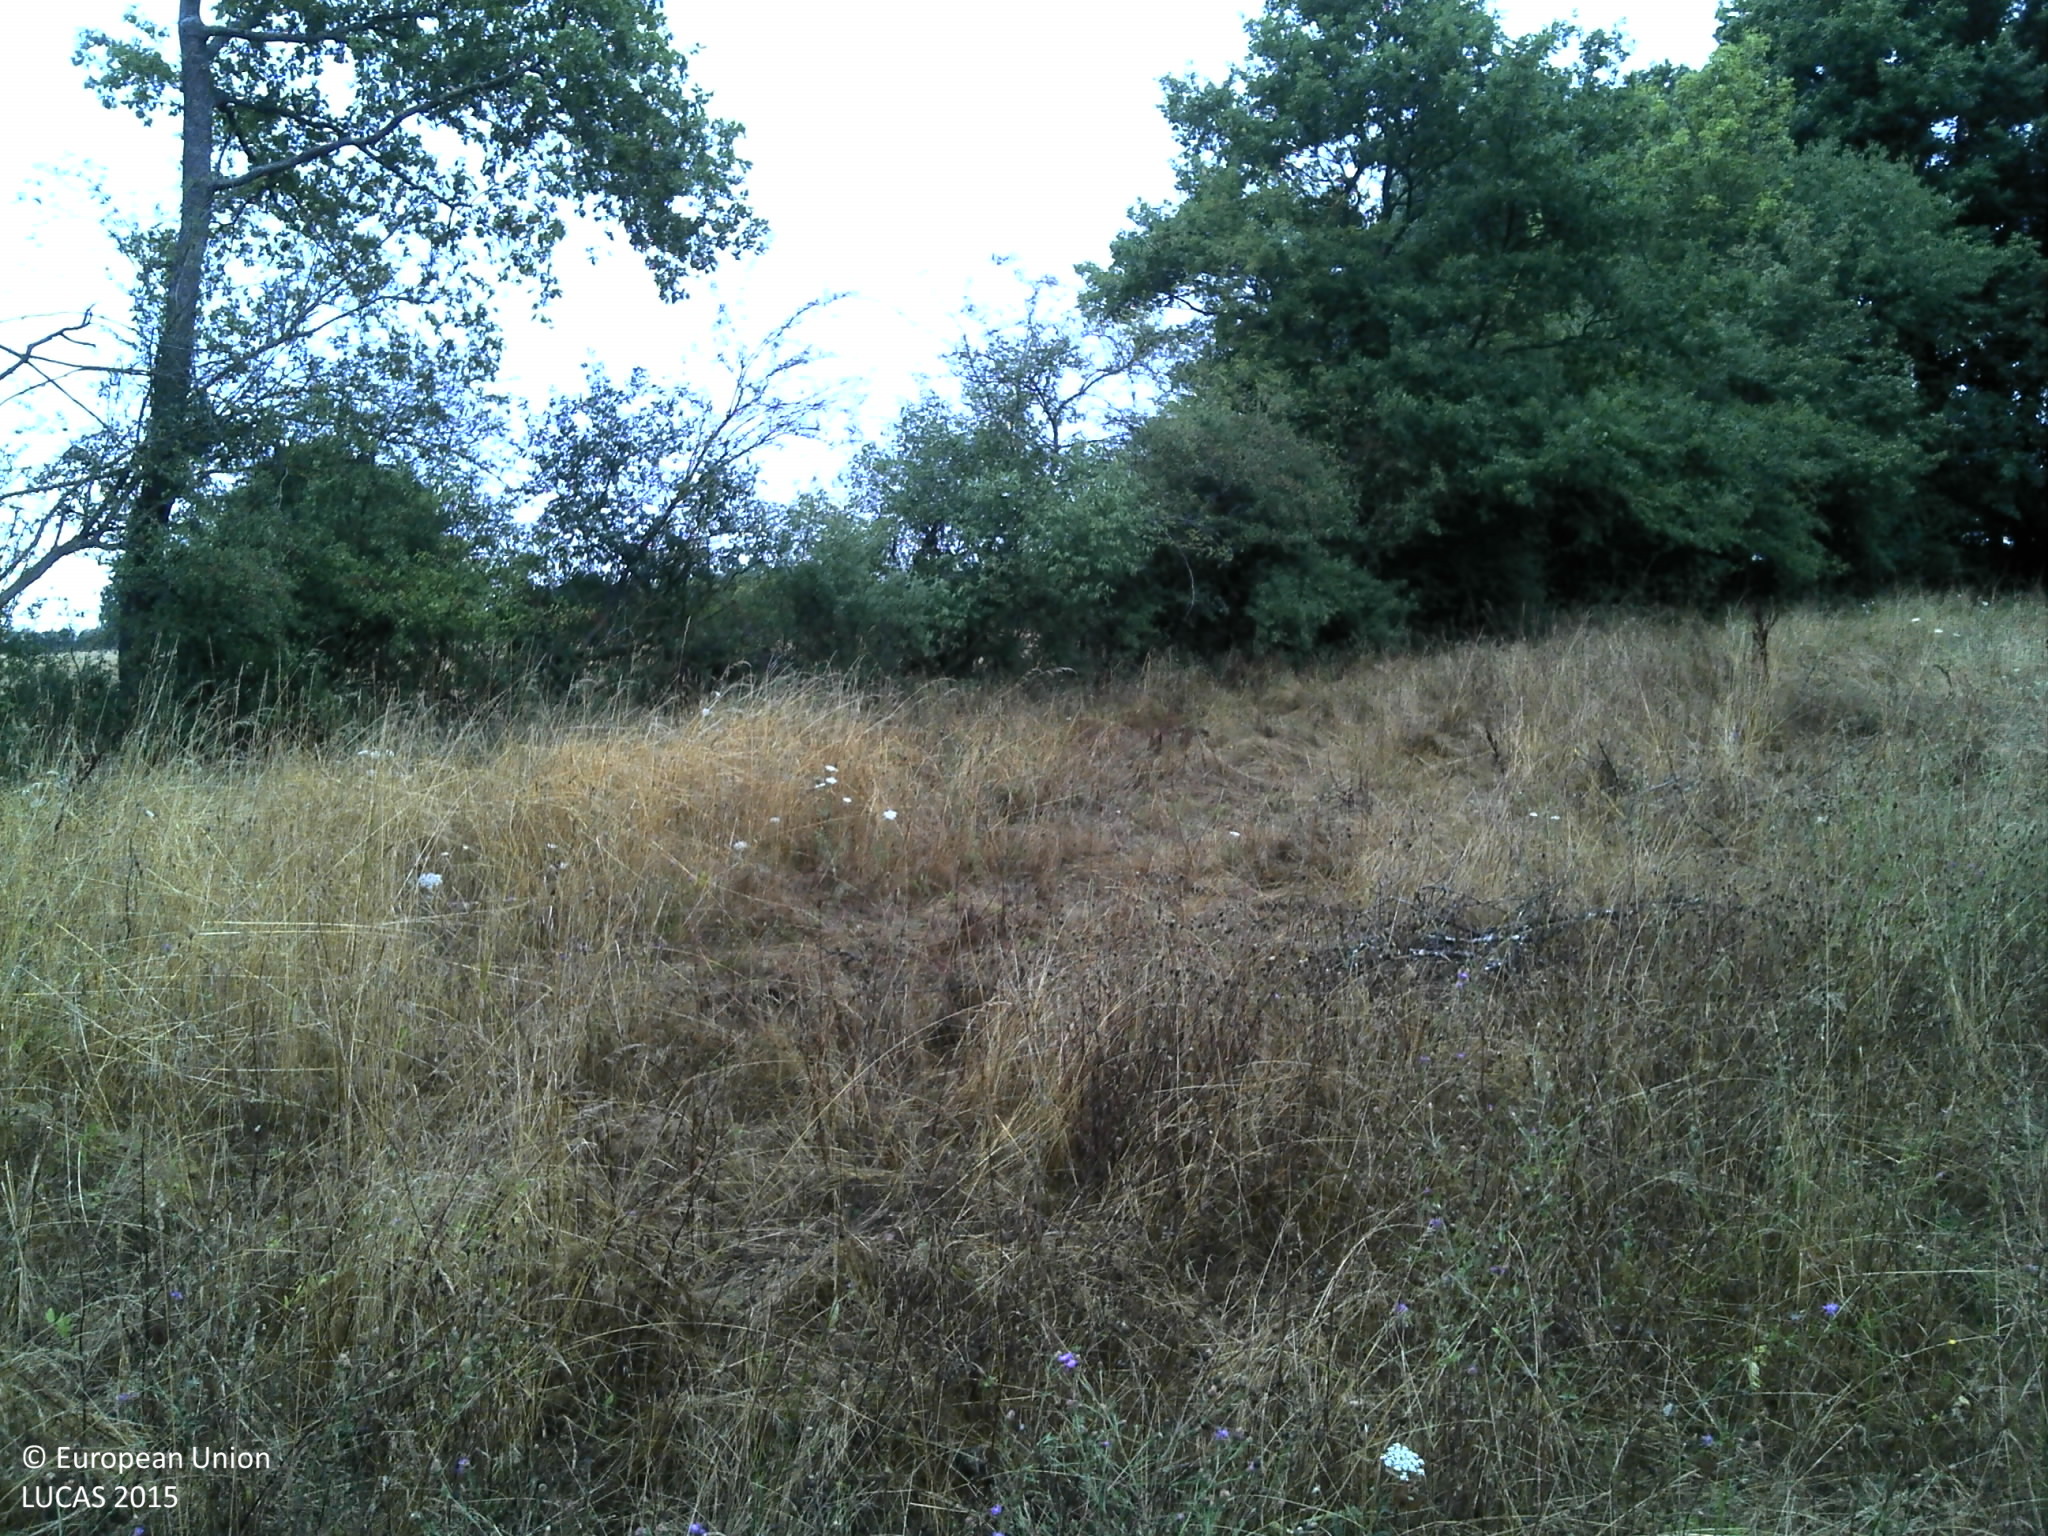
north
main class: Grassland
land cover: Grassland without tree/shrub cover
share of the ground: > 75 %
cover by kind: herbaceous plants 100 %
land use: Agriculture (excluding fallow land and kitchen gardens)
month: August
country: FR
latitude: 46.1679
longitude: 4.0564
